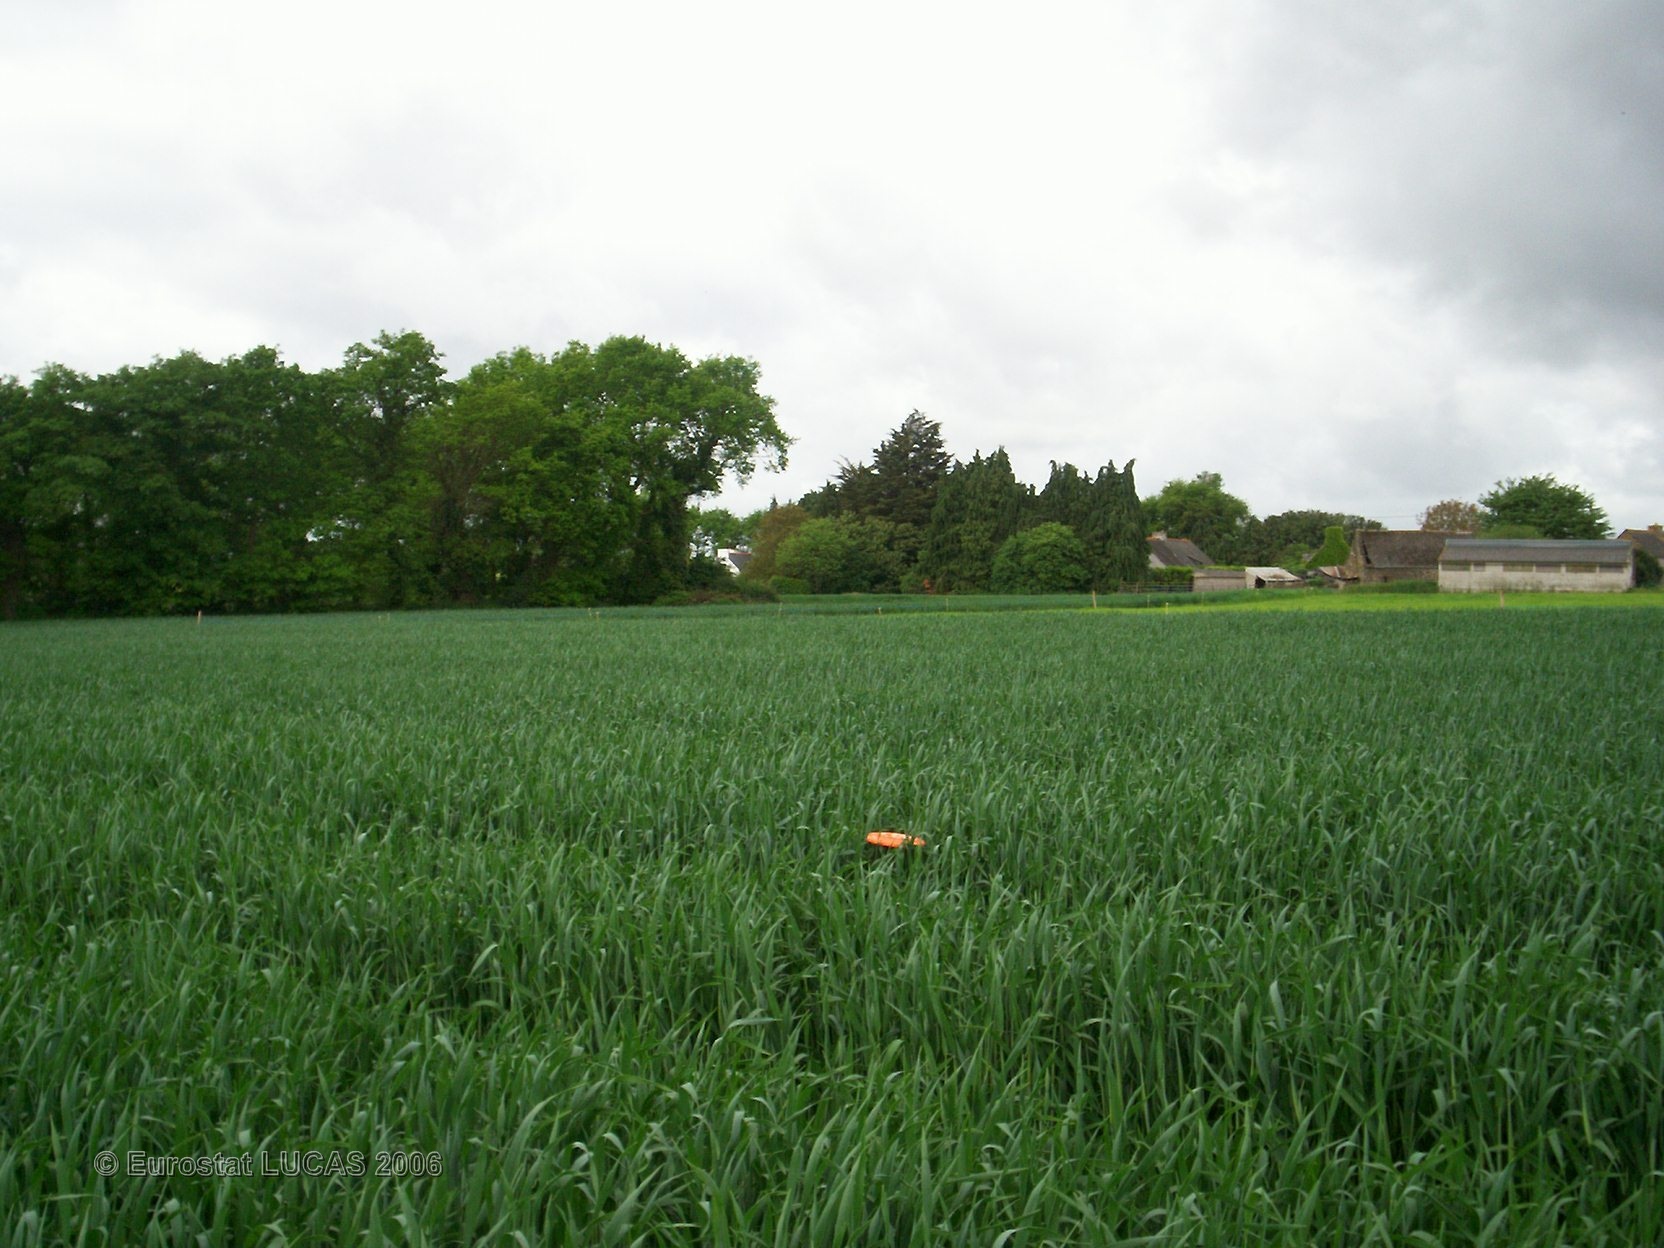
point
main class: Cropland
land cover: Common wheat
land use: Agriculture (excluding fallow land and kitchen gardens)
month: May
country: FR
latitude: 47.9352
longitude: -2.9028
